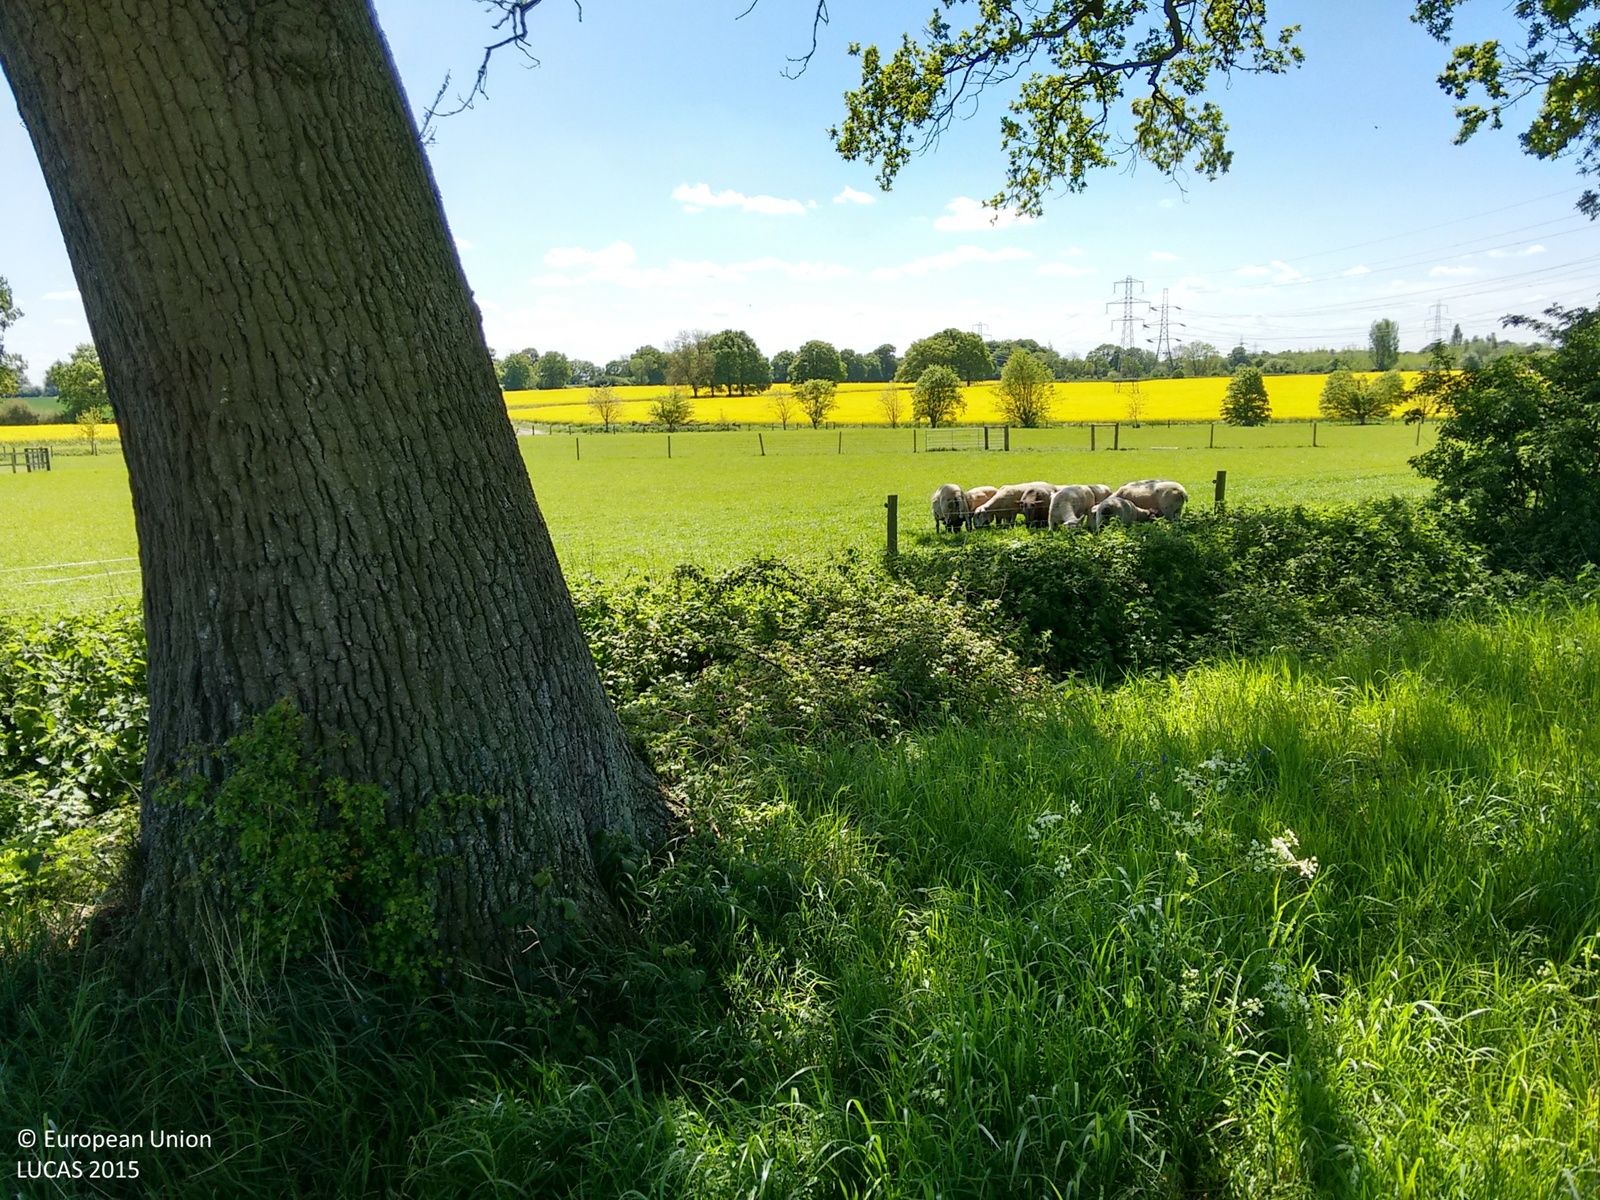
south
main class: Cropland
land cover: Rape and turnip rape
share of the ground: > 75 %
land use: Agriculture (excluding fallow land and kitchen gardens)
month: May
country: GB
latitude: 51.3508
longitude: -1.0582
